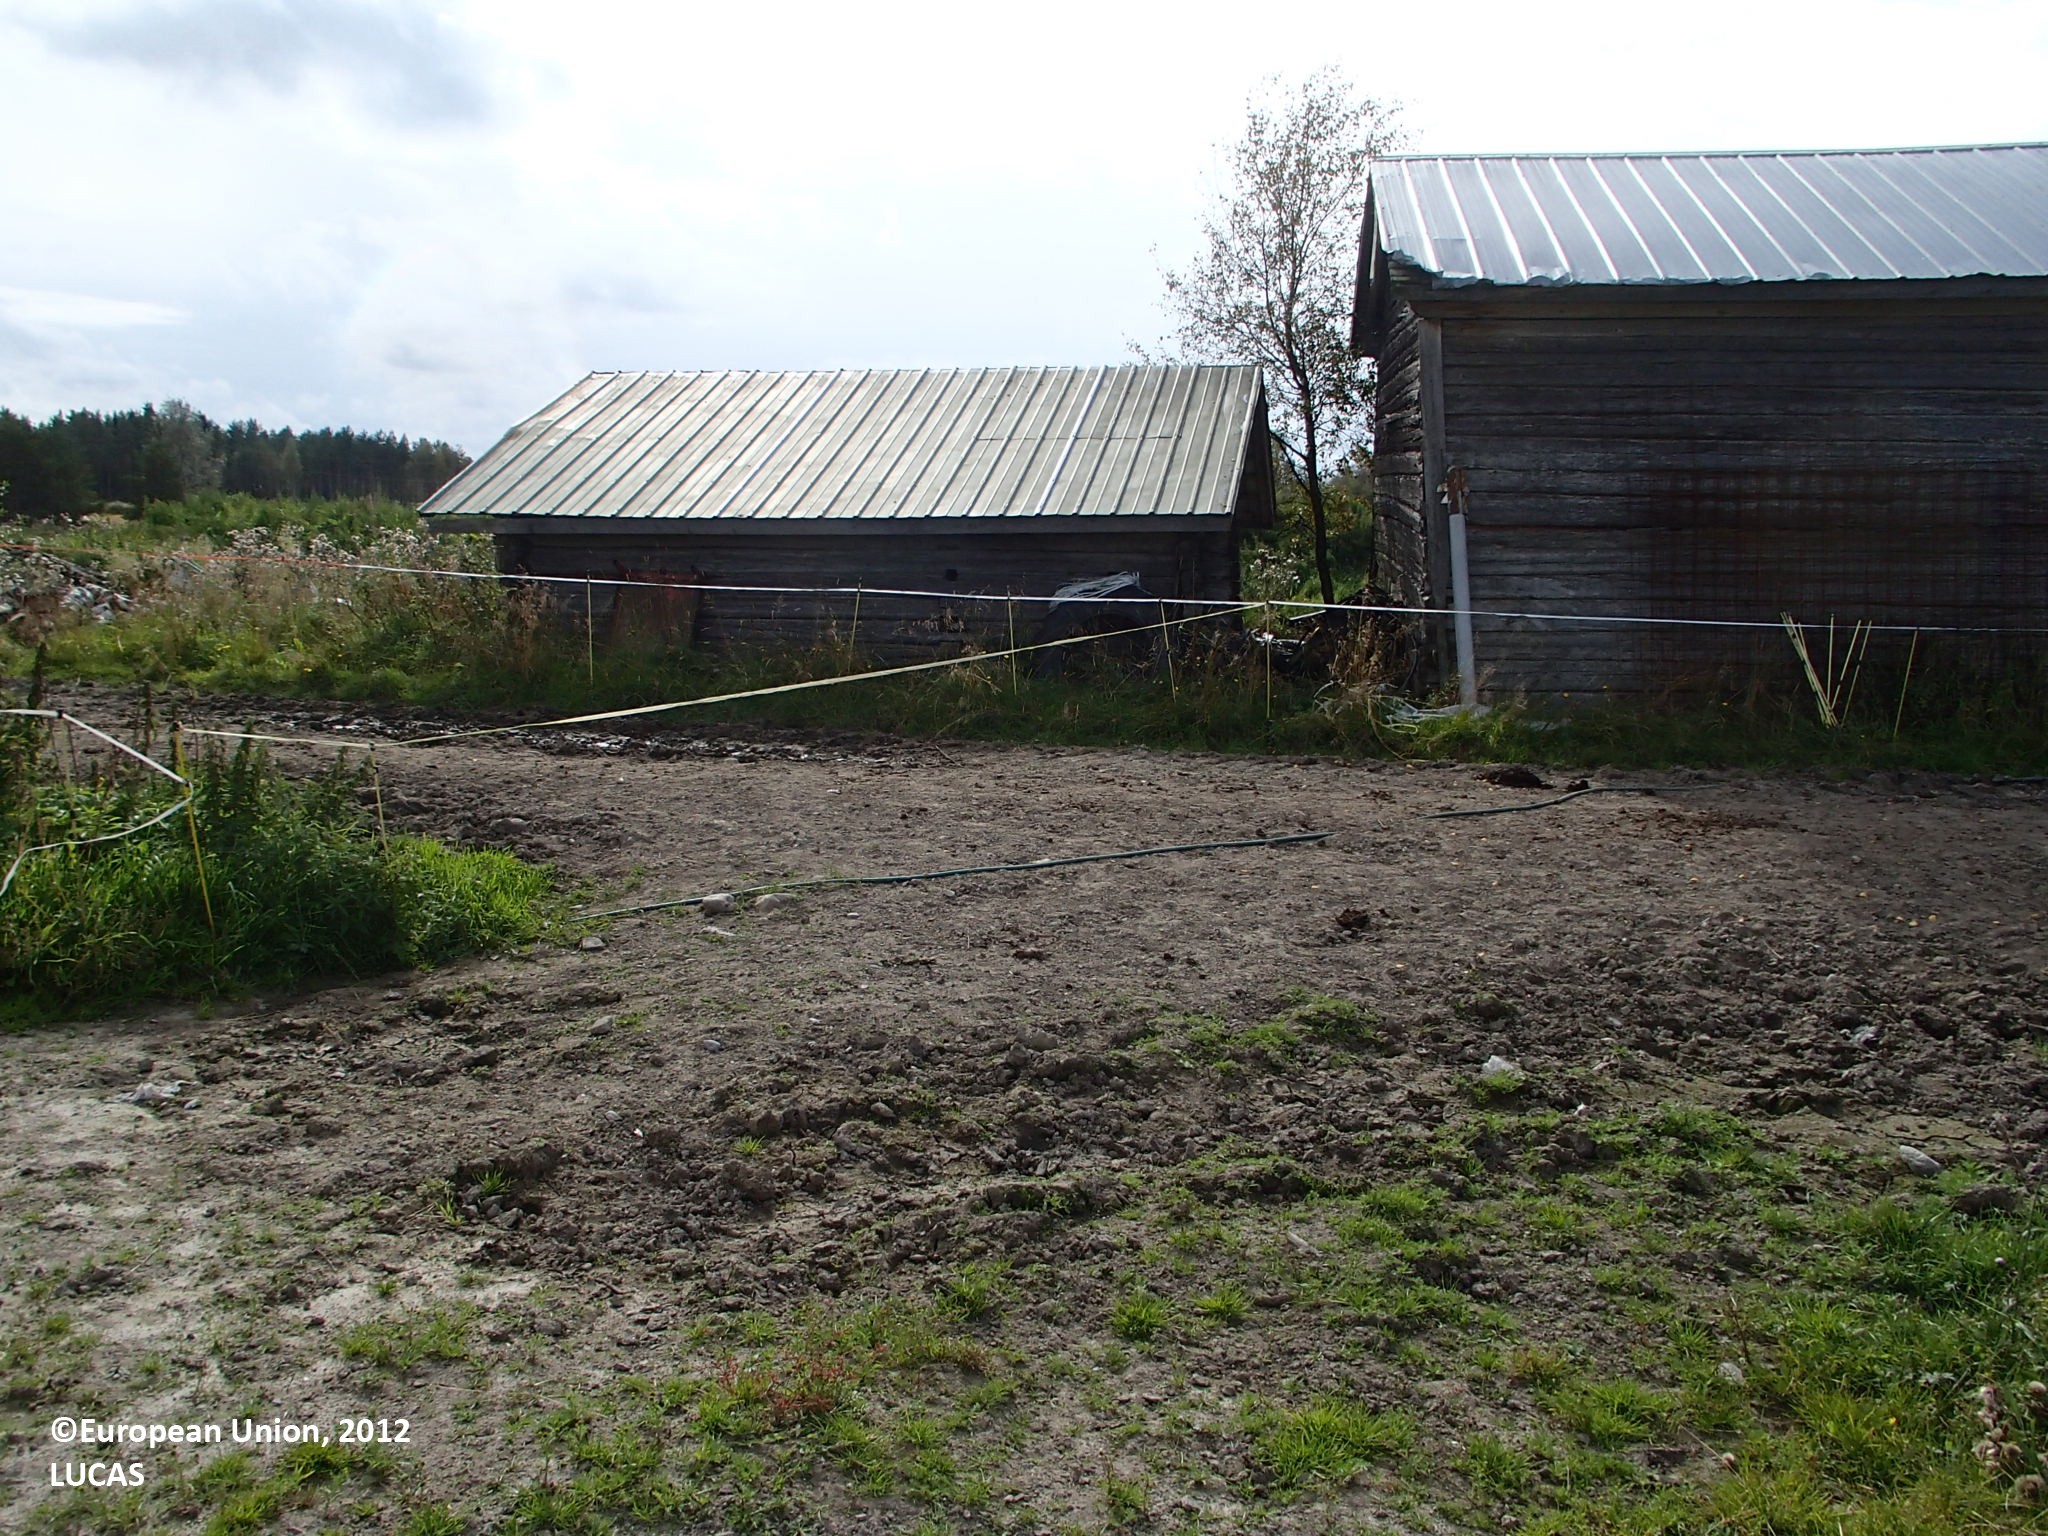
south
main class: Cropland
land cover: Temporary grasslands
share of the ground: > 75 %
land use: Agriculture (excluding fallow land and kitchen gardens)
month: September
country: FI
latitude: 63.7864
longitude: 25.9566
